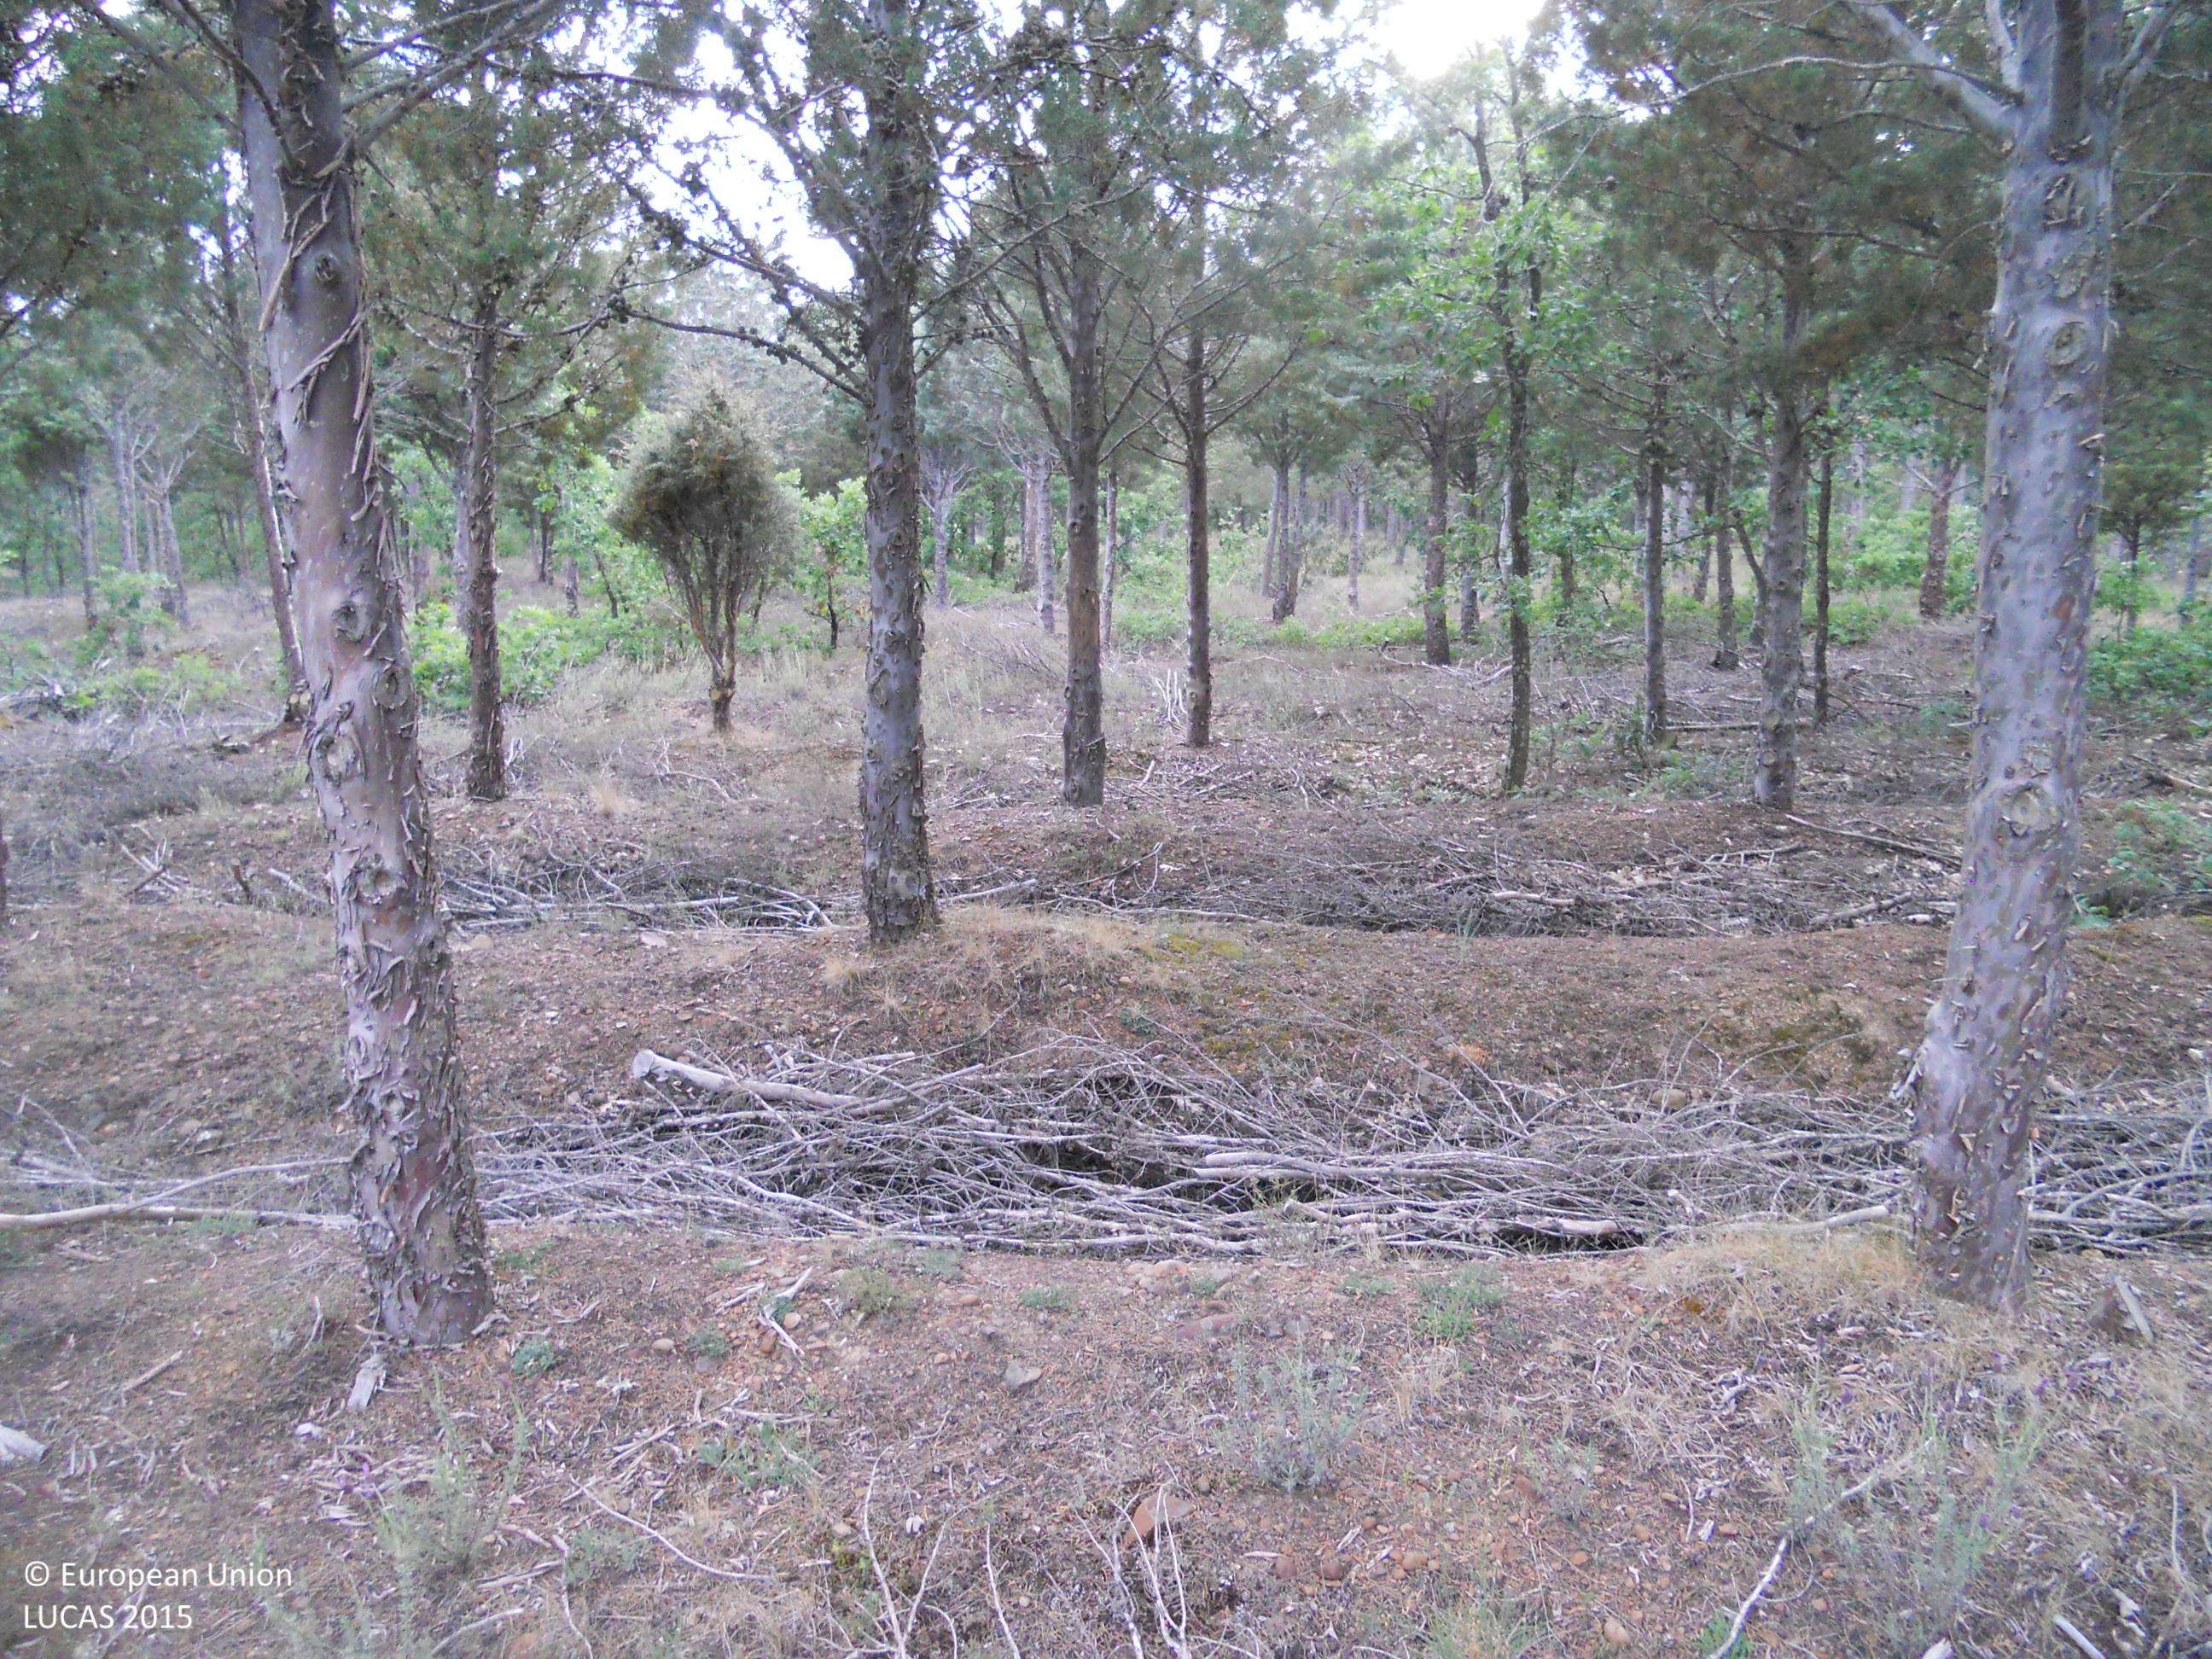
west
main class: Woodland
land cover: Other mixed woodland
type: acidophilous oak and oak-birch forest
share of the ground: > 75 %
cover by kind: broadleaved forest trees 35 %, herbaceous plants 20 %, coniferous forest trees 15 %, shrubs 5 %, unconsolidated bare surface 5 %
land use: Forestry
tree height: < 5 m
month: June
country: ES
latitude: 42.3616
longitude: -4.8320
